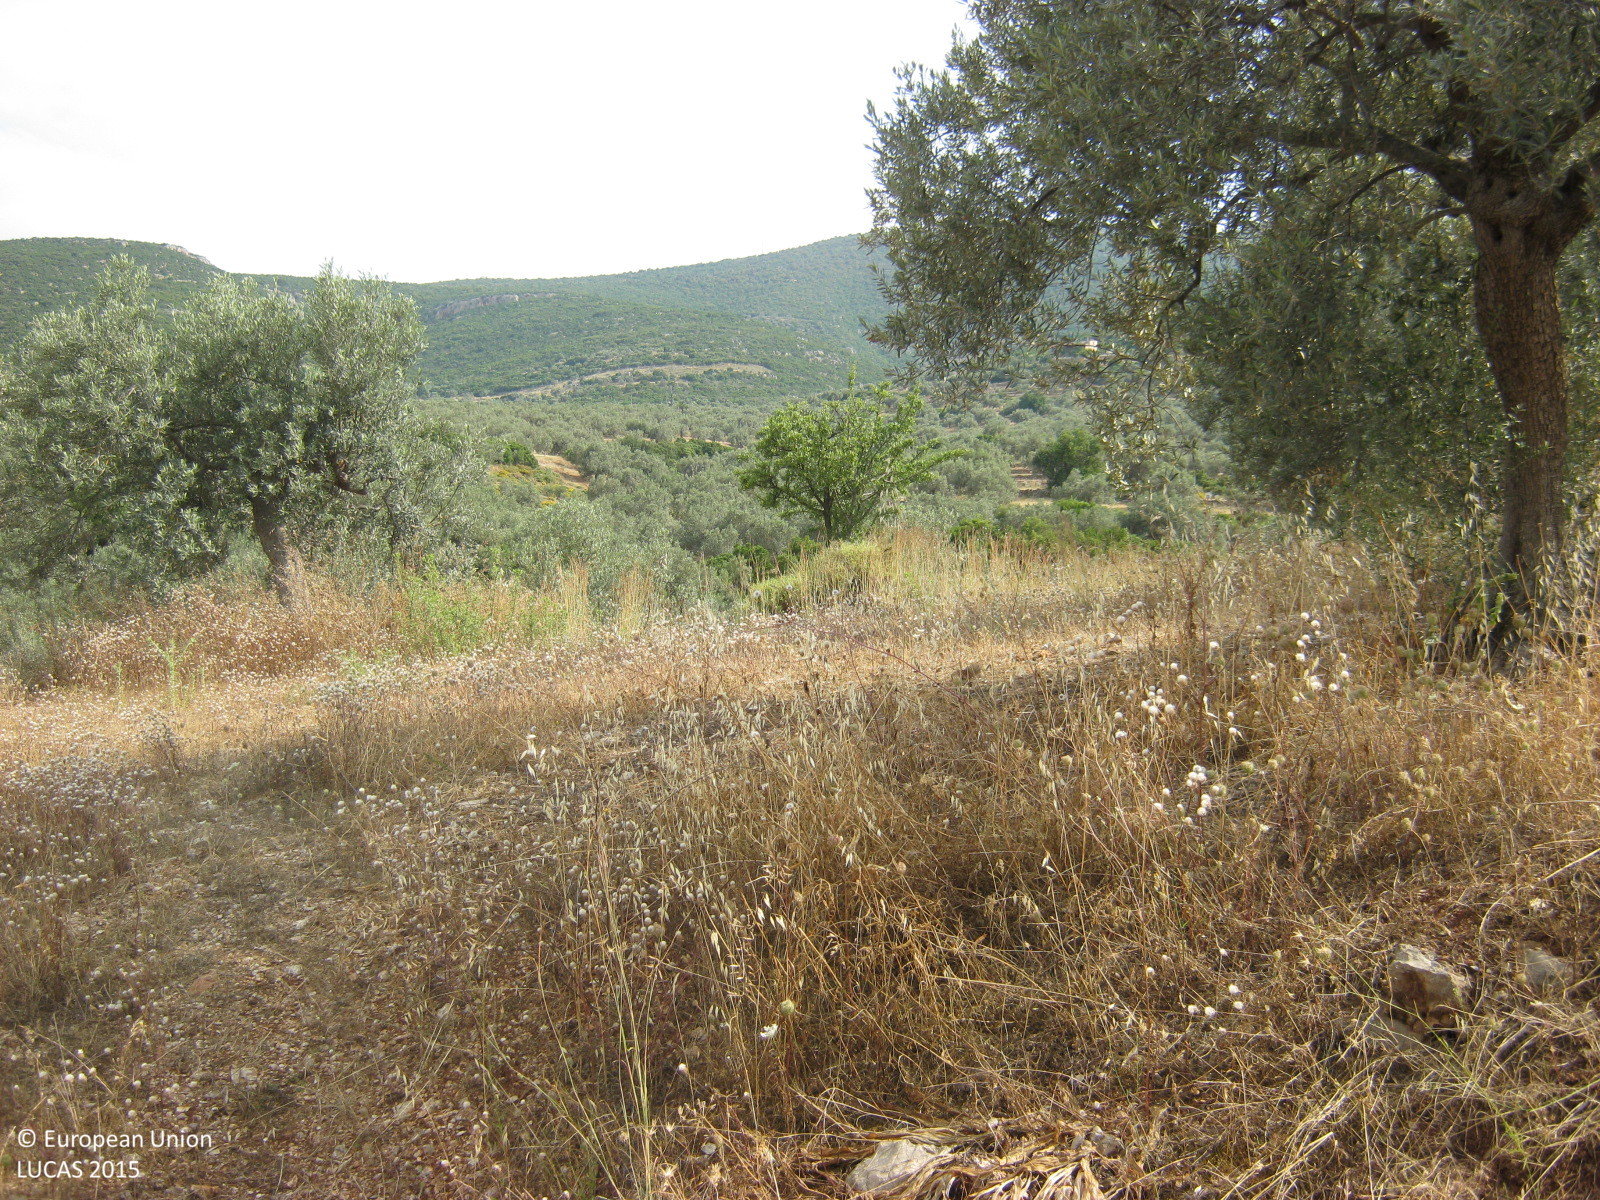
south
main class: Cropland
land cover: Olive groves
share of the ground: > 75 %
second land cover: Rocks and stones
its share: > 75 %
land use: Agriculture (excluding fallow land and kitchen gardens)
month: June
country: GR
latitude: 37.4749
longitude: 22.7303
